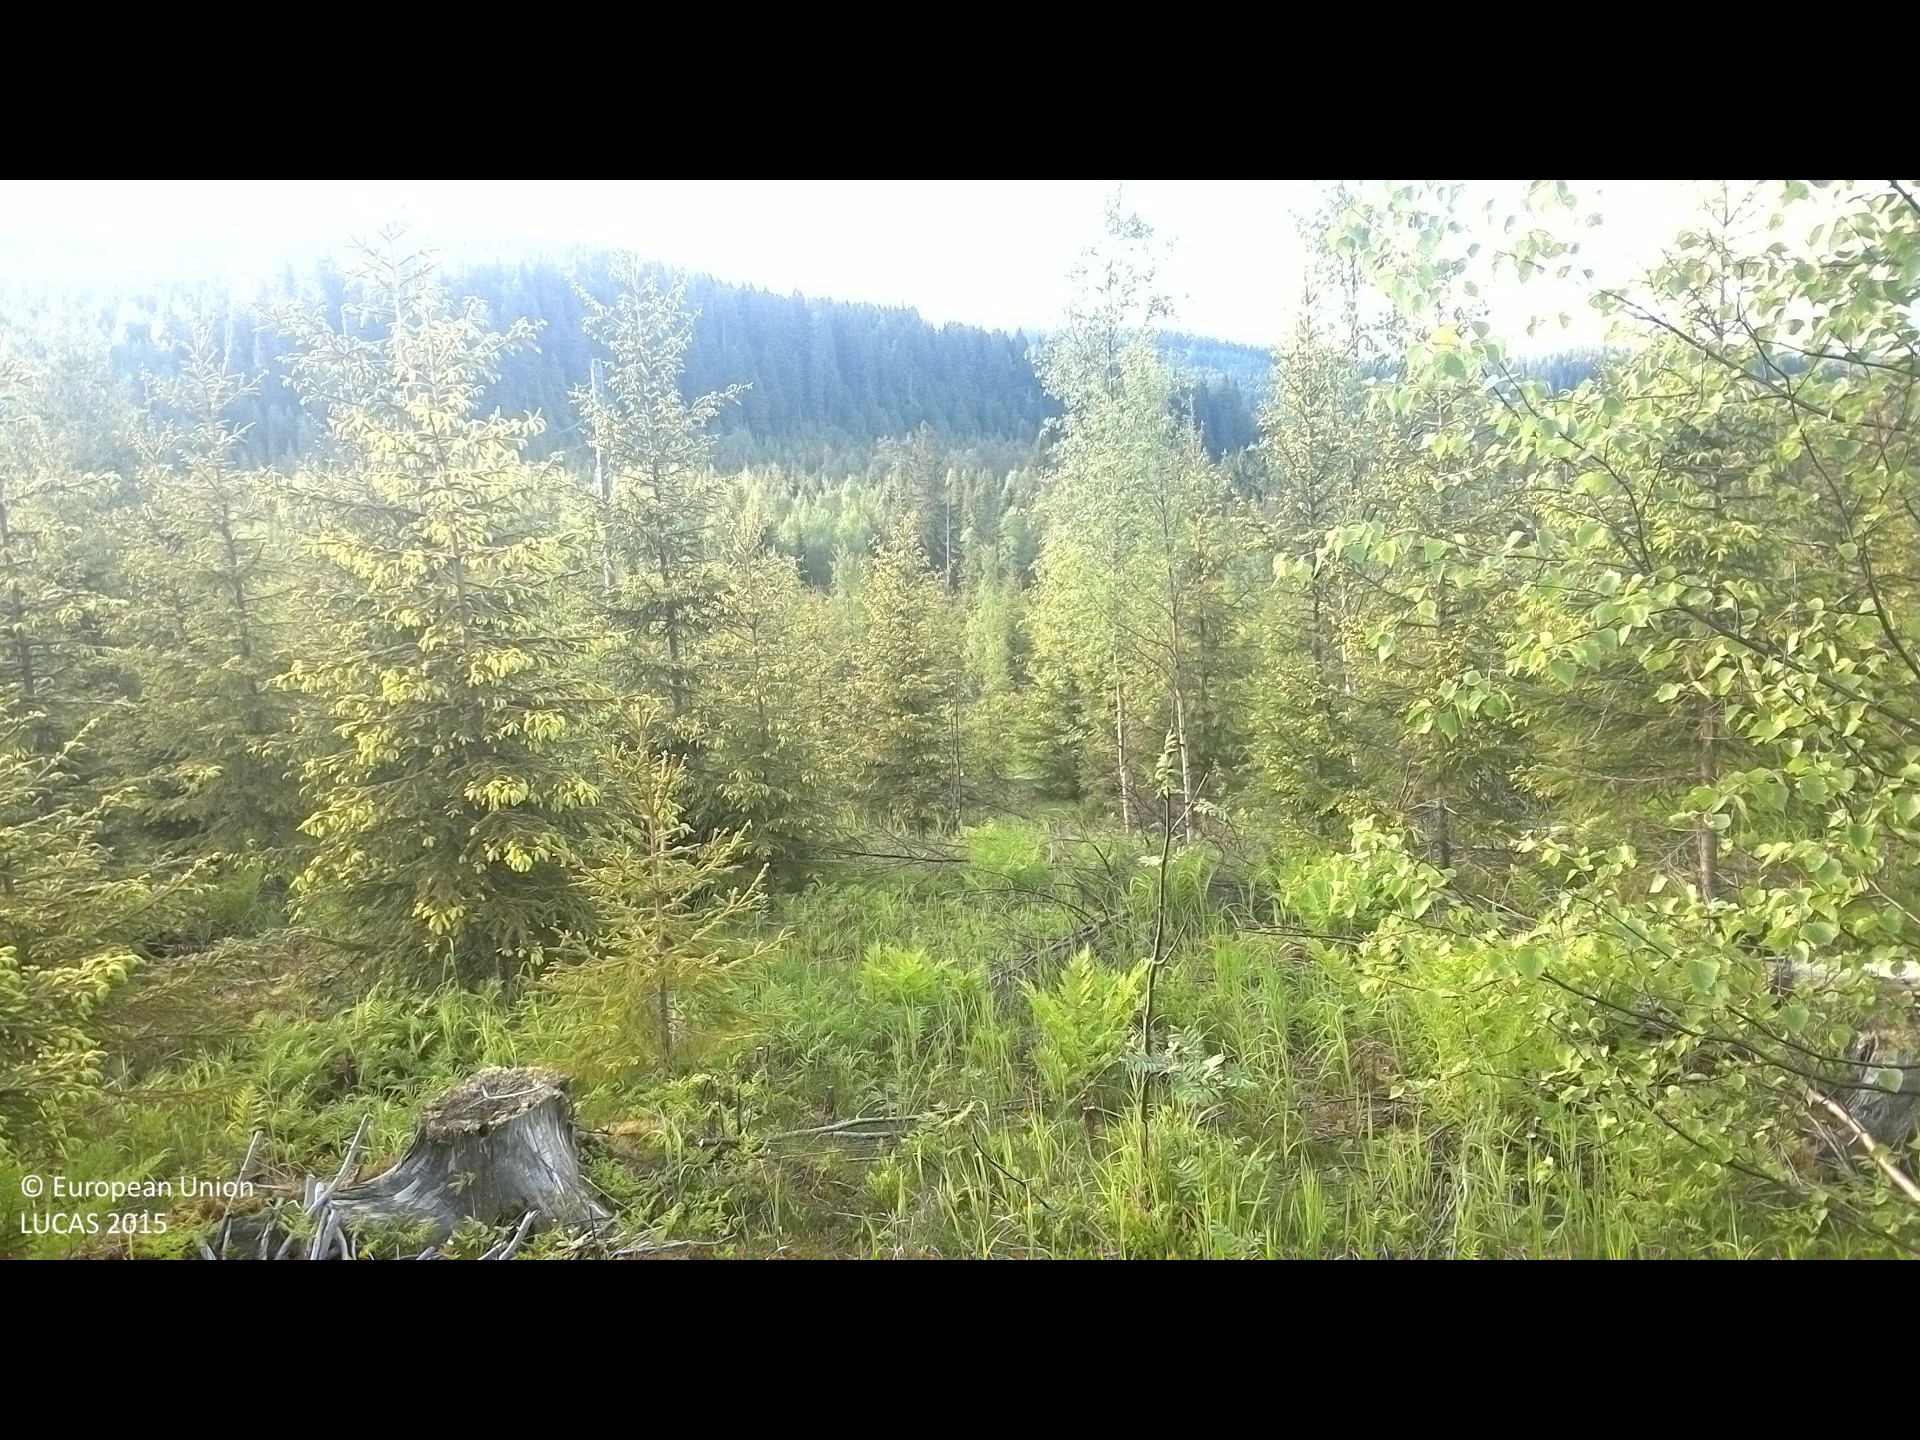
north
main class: Woodland
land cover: Spruce dominated coniferous woodland
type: boreal forest
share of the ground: 25 - 50 %
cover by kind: herbaceous plants 50 %, coniferous forest trees 25 %, lichens and mosses 20 %, broadleaved forest trees 5 %
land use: Forestry
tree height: < 5 m
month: June
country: SE
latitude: 62.0276
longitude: 16.7279
